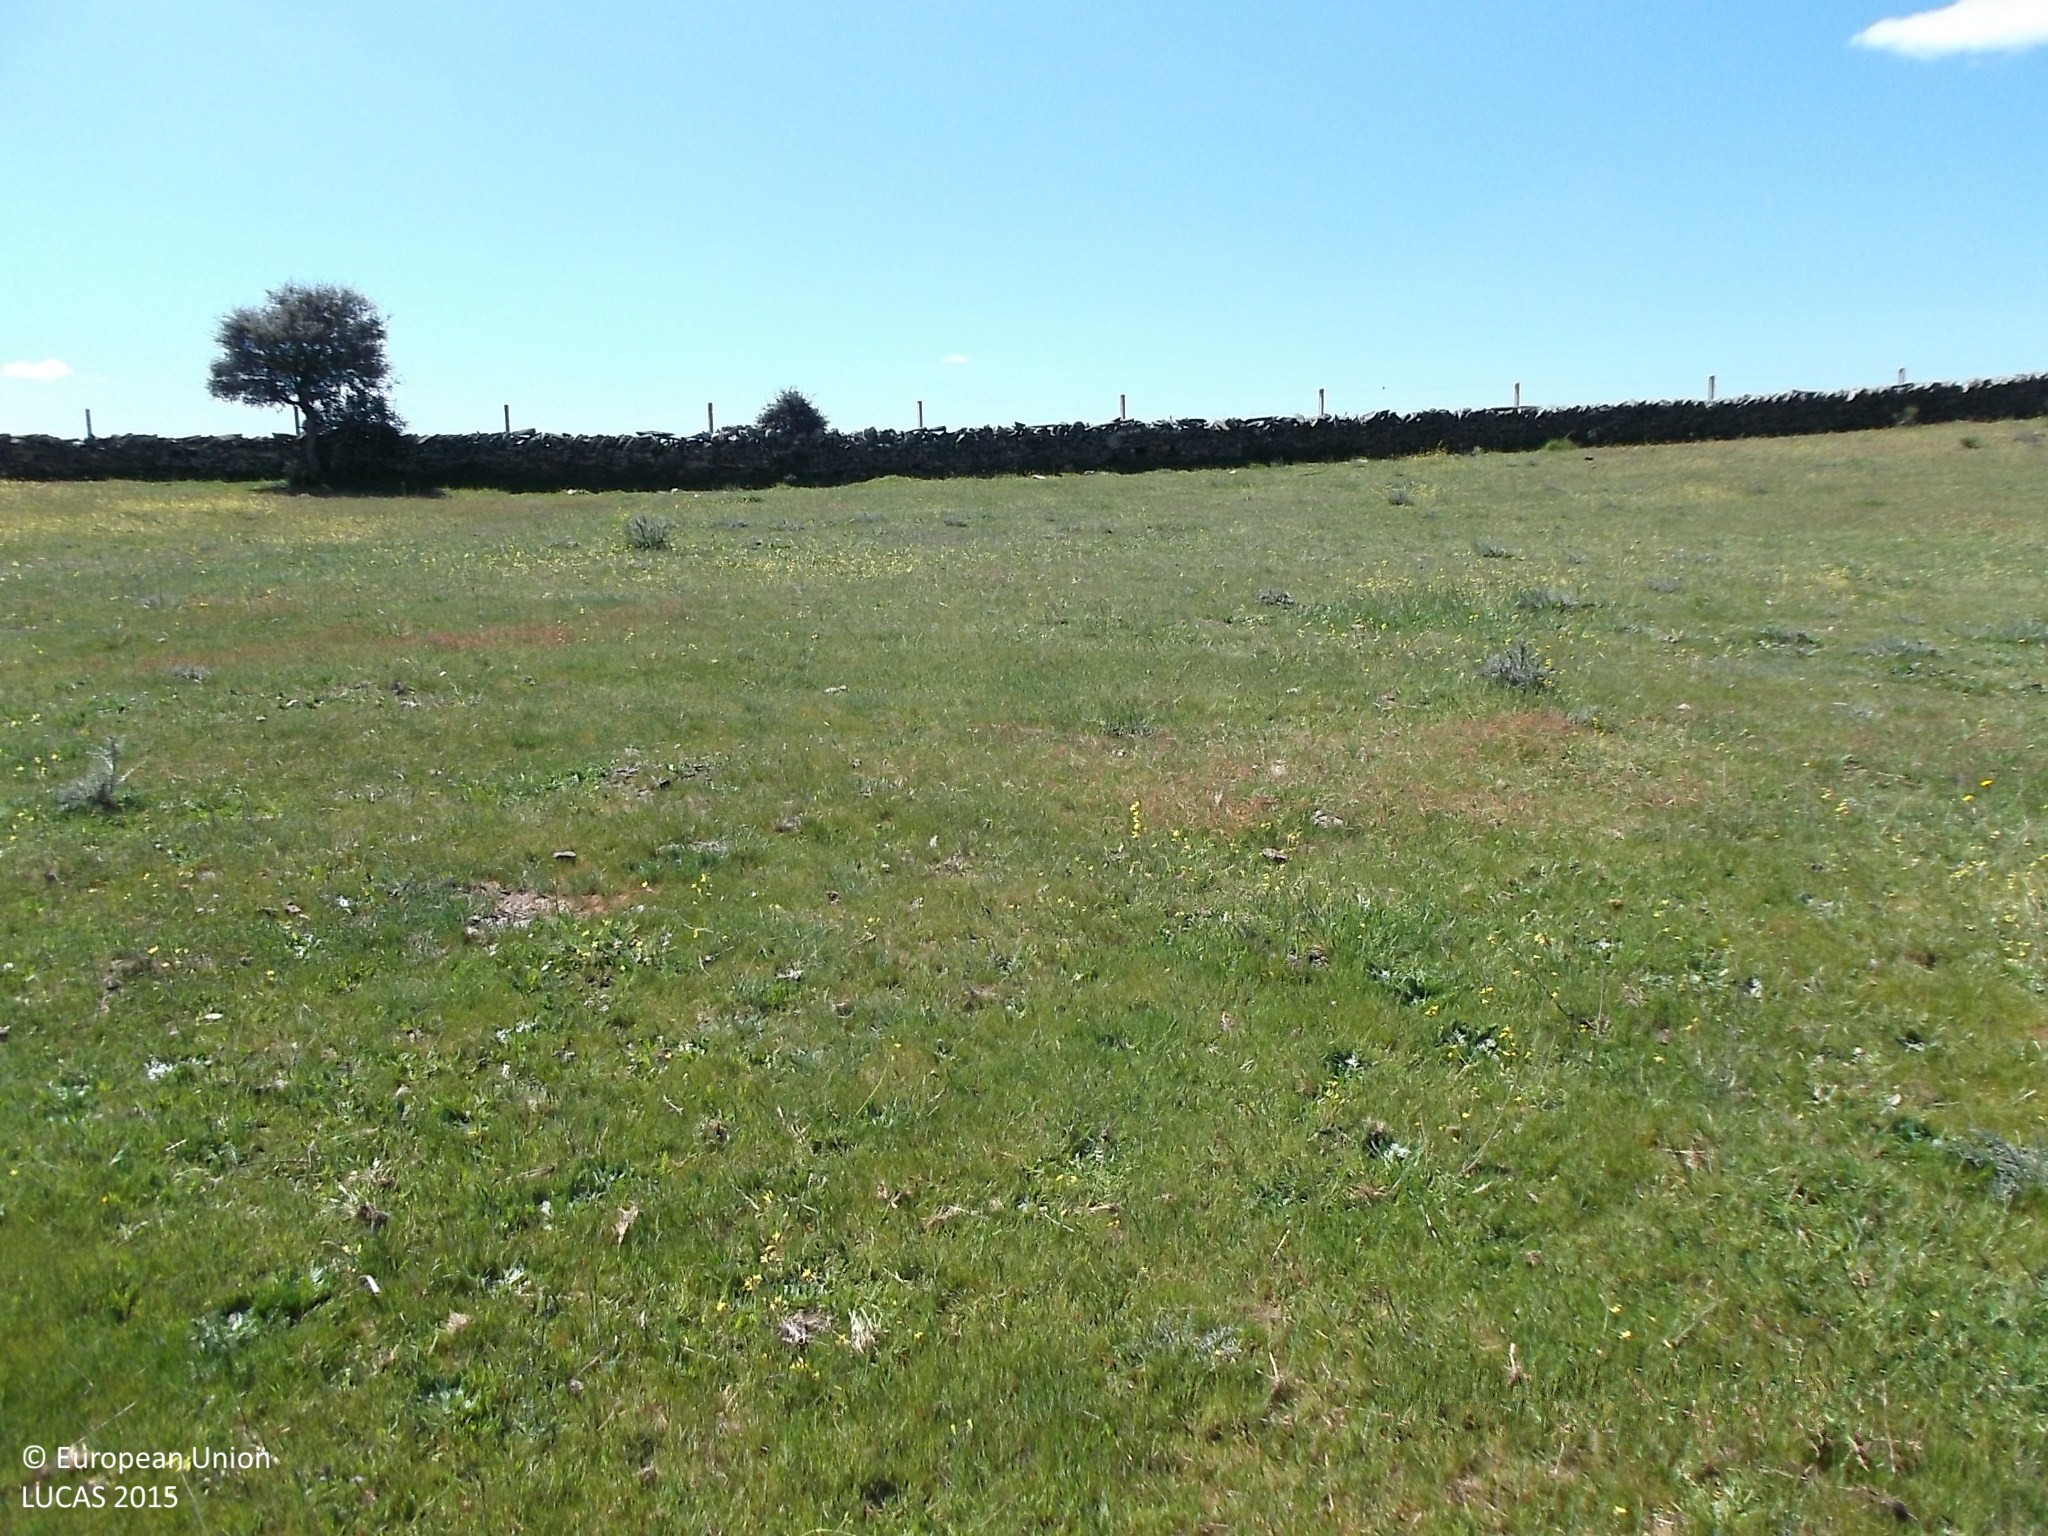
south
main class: Grassland
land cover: Grassland without tree/shrub cover
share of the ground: > 75 %
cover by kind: herbaceous plants 100 %
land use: Agriculture (excluding fallow land and kitchen gardens)
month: April
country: ES
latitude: 41.0508
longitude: -5.9436
